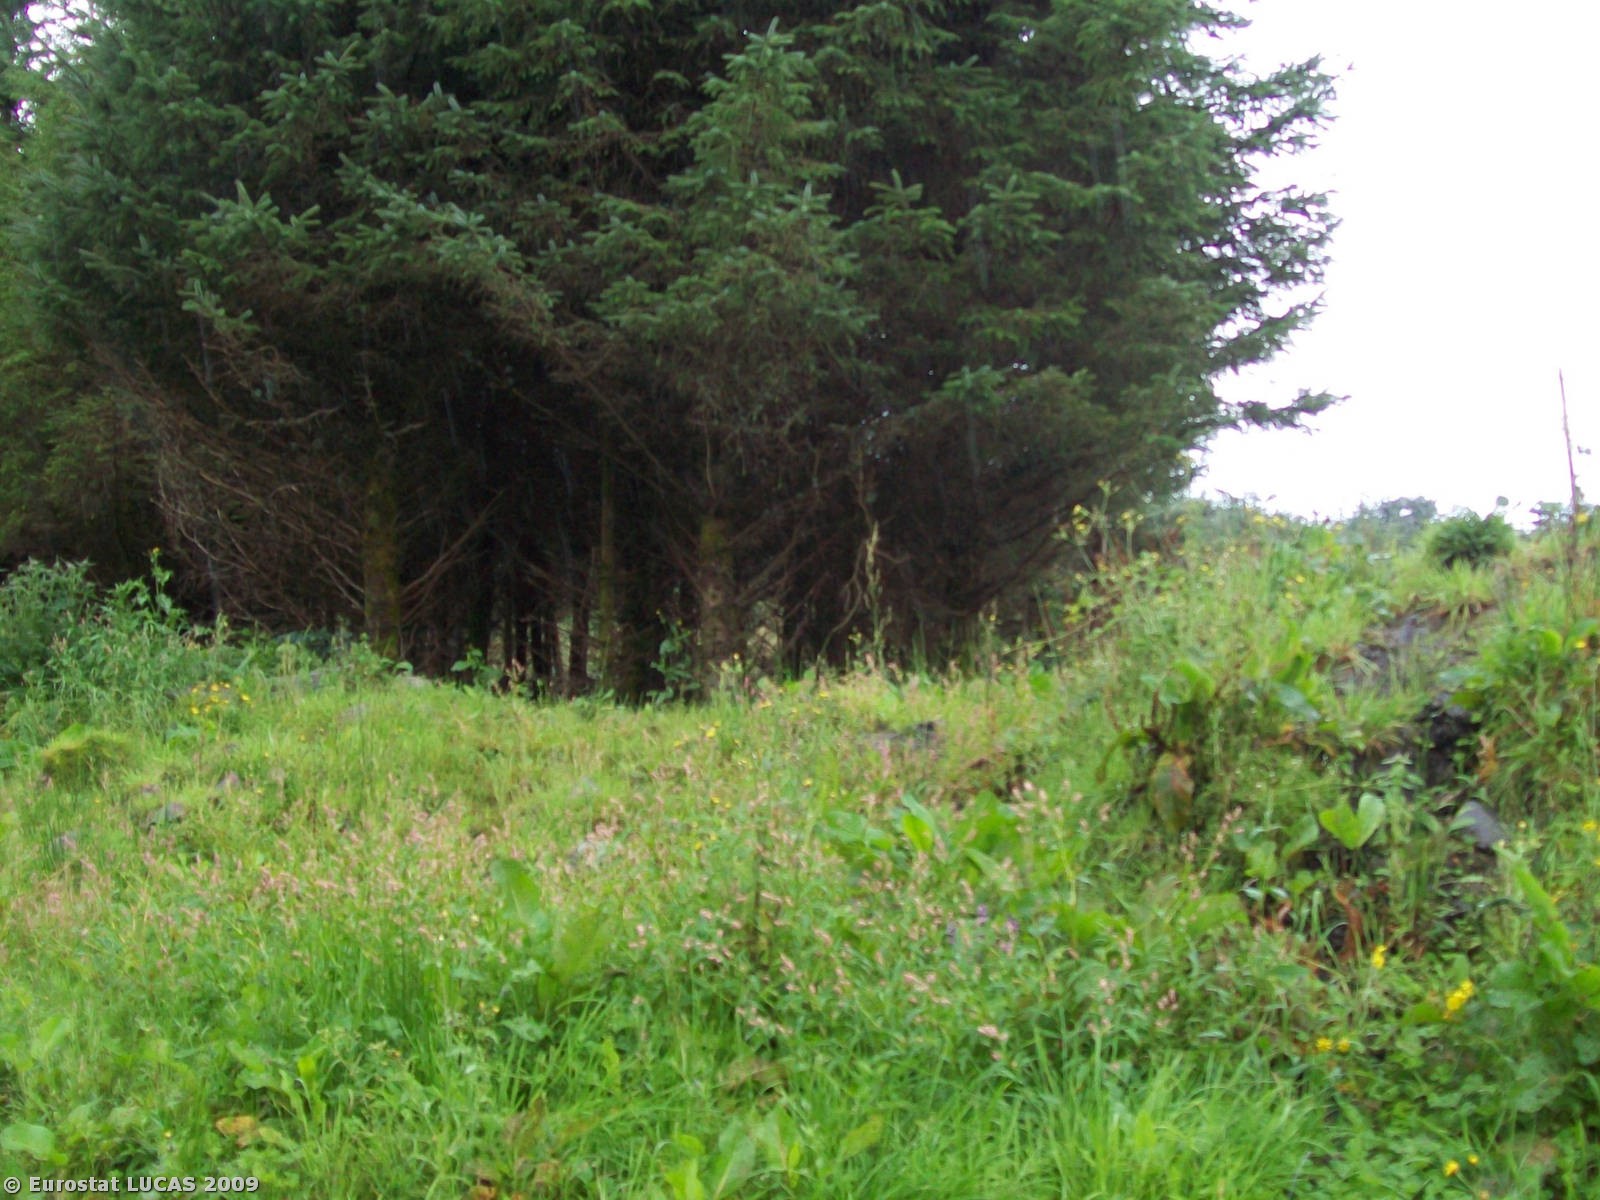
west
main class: Woodland
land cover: Coniferous woodland
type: plantations and self-sown exotic forest
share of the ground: > 75 %
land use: Forestry
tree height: > 5 m
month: August
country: IE
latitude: 52.9969
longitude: -9.2805
